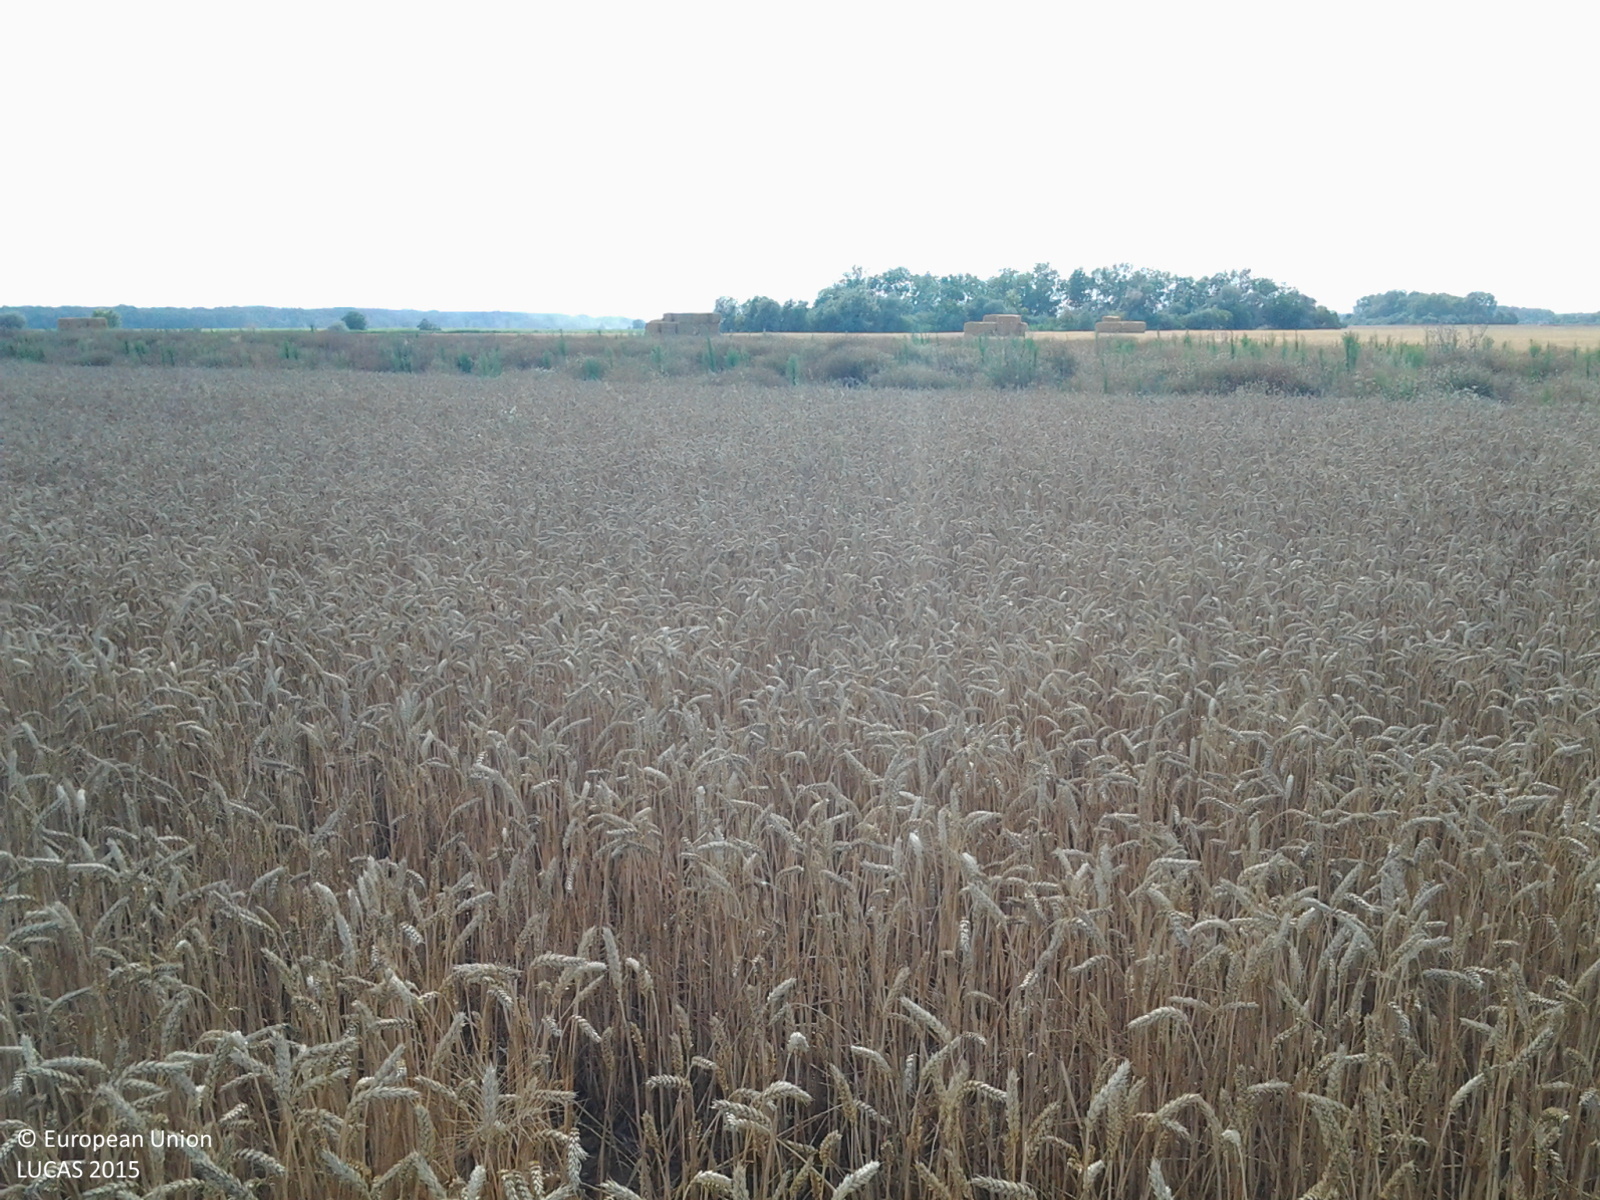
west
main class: Cropland
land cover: Common wheat
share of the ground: > 75 %
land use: Agriculture (excluding fallow land and kitchen gardens)
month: July
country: HU
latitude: 47.2761
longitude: 20.4062
